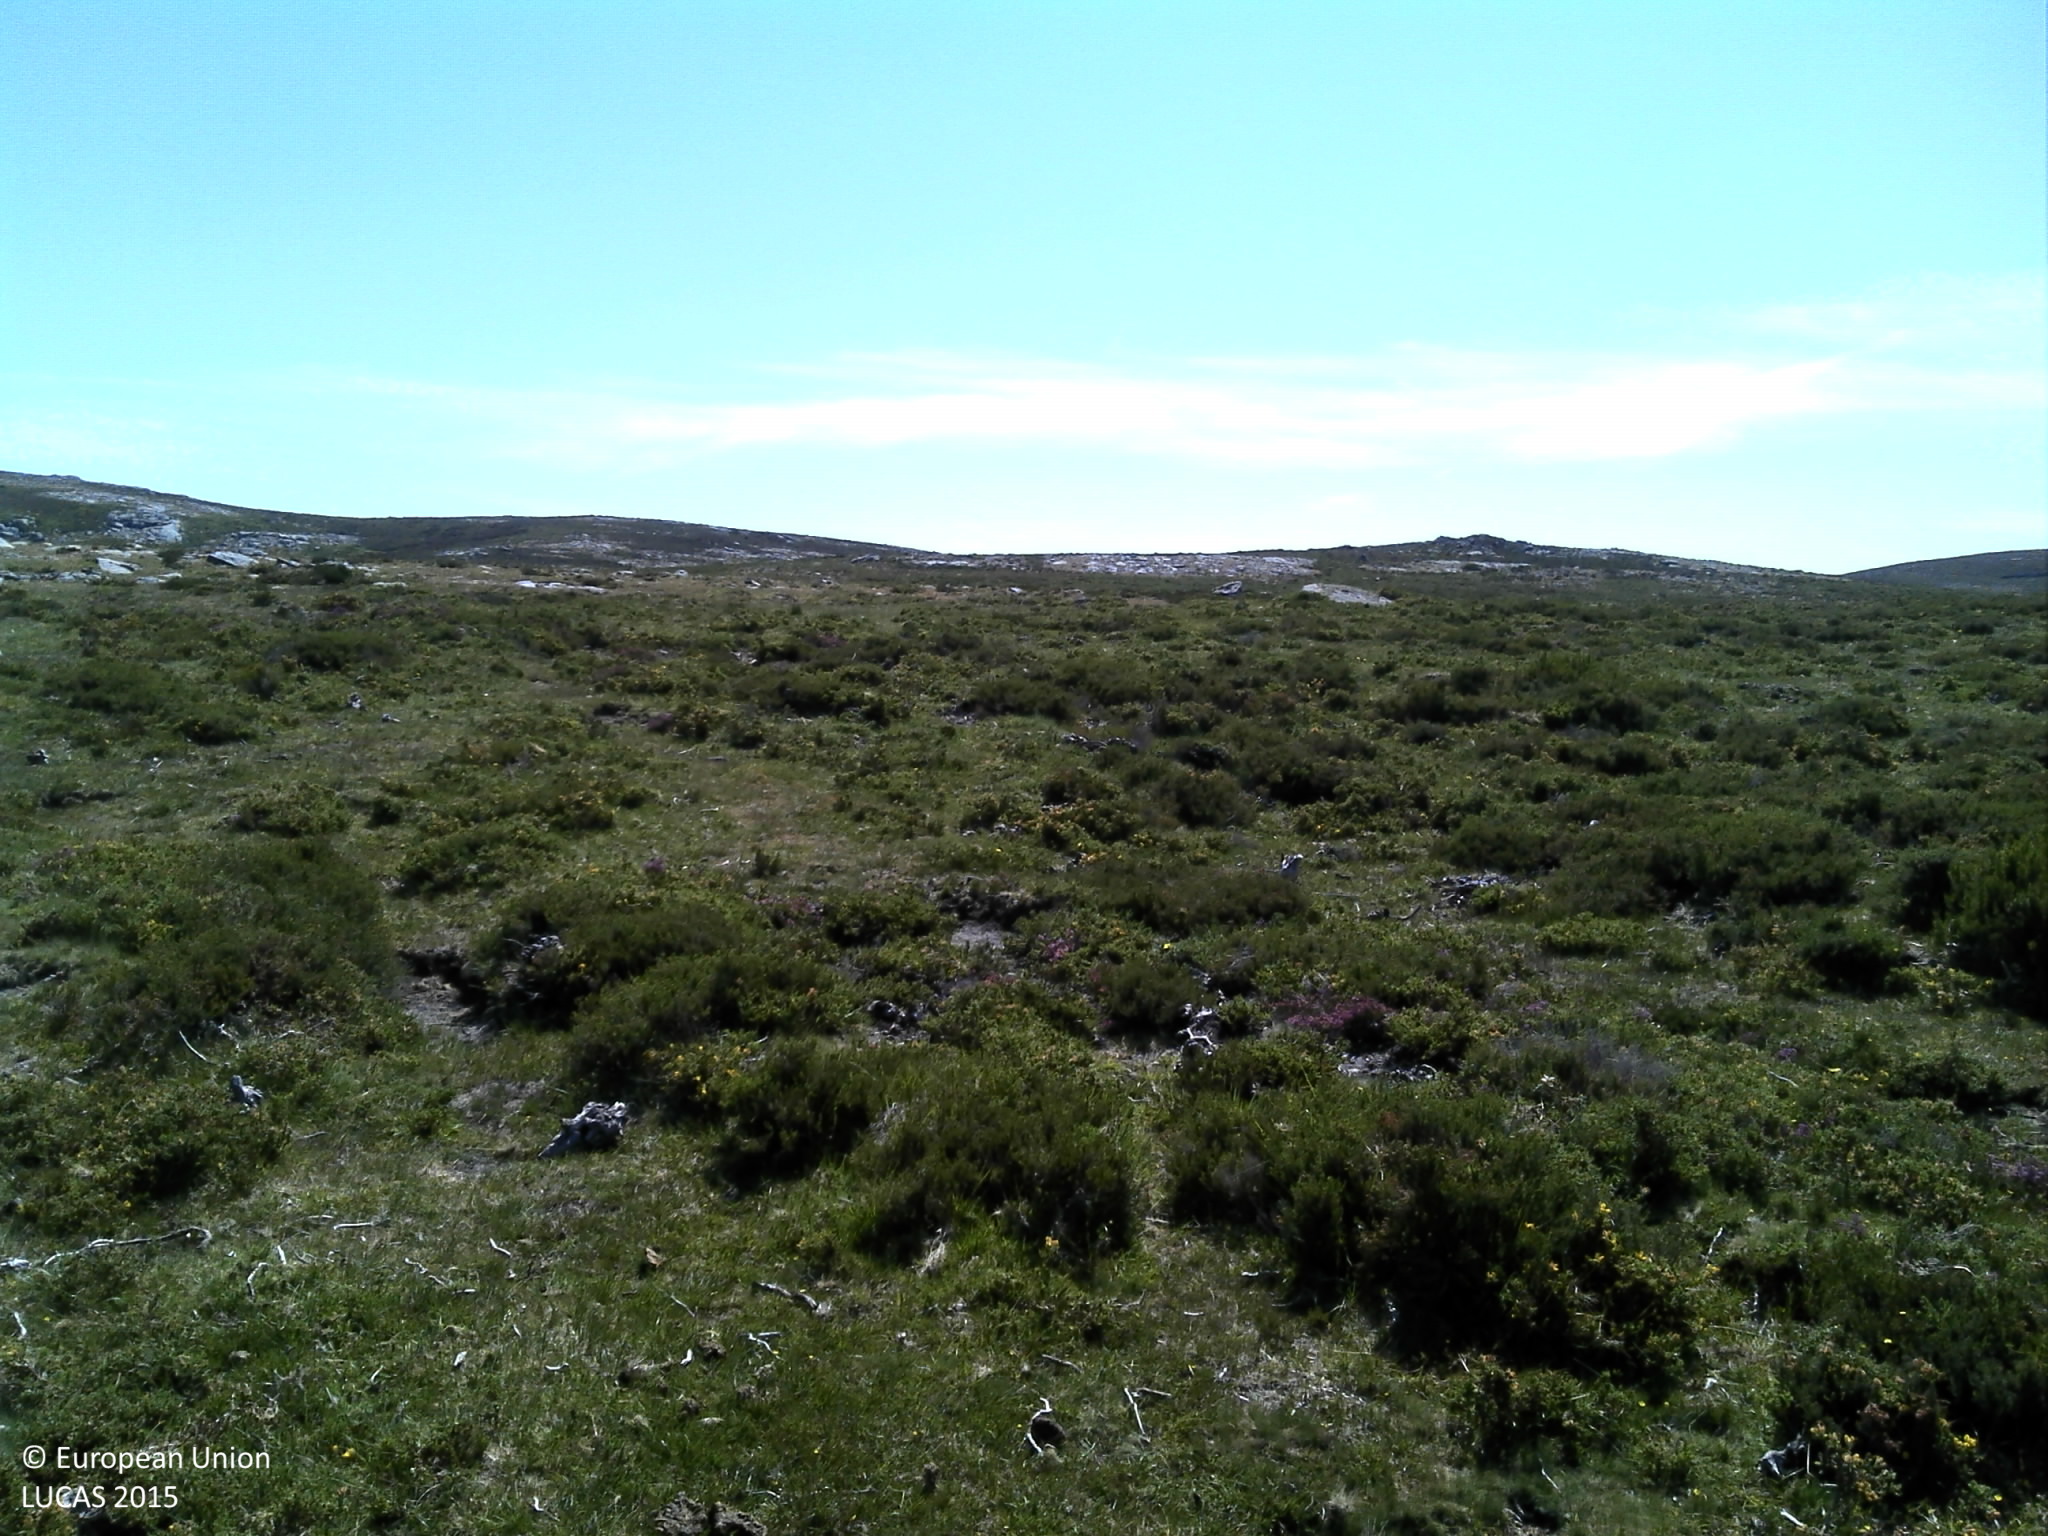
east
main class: Shrubland
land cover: Shrubland without tree cover
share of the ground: 50 - 75 %
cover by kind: shrubs 70 %, herbaceous plants 20 %, consolidated bare surface 5 %, unconsolidated bare surface 5 %
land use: Agriculture (excluding fallow land and kitchen gardens)
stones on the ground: < 10 %
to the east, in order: Shrubland without tree cover; Rocks and stones; Shrubland without tree cover
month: June
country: PT
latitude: 41.9642
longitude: -8.3167
